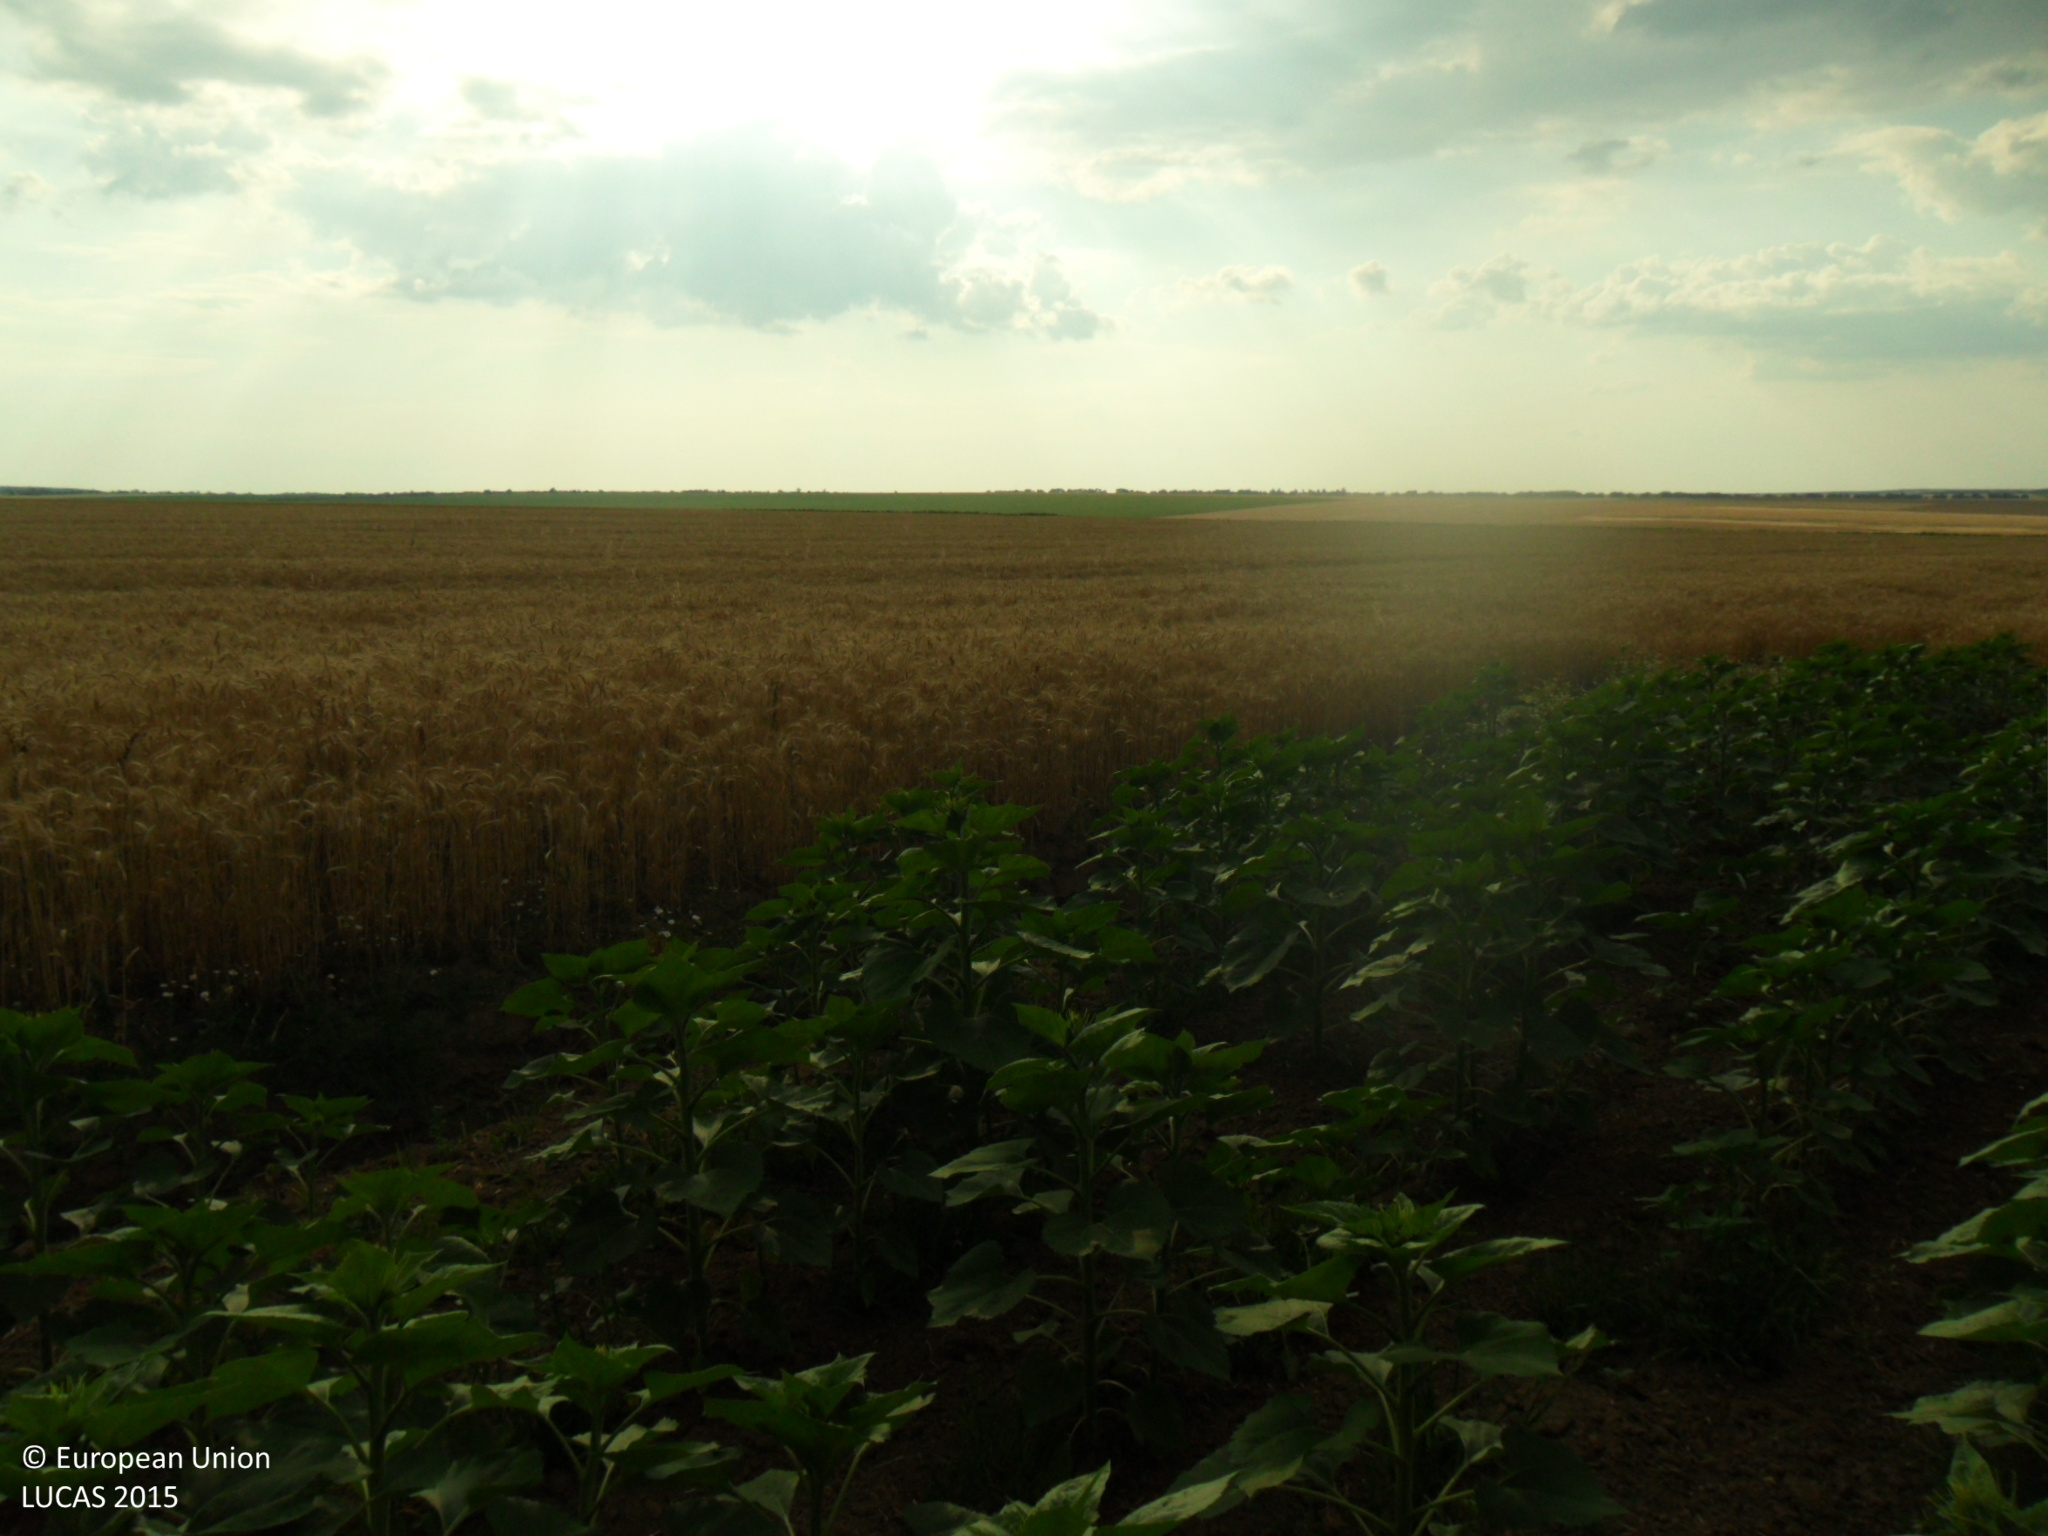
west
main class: Cropland
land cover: Sunflower
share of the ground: > 75 %
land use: Agriculture (excluding fallow land and kitchen gardens)
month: July
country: BG
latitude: 43.5730
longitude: 26.8174
